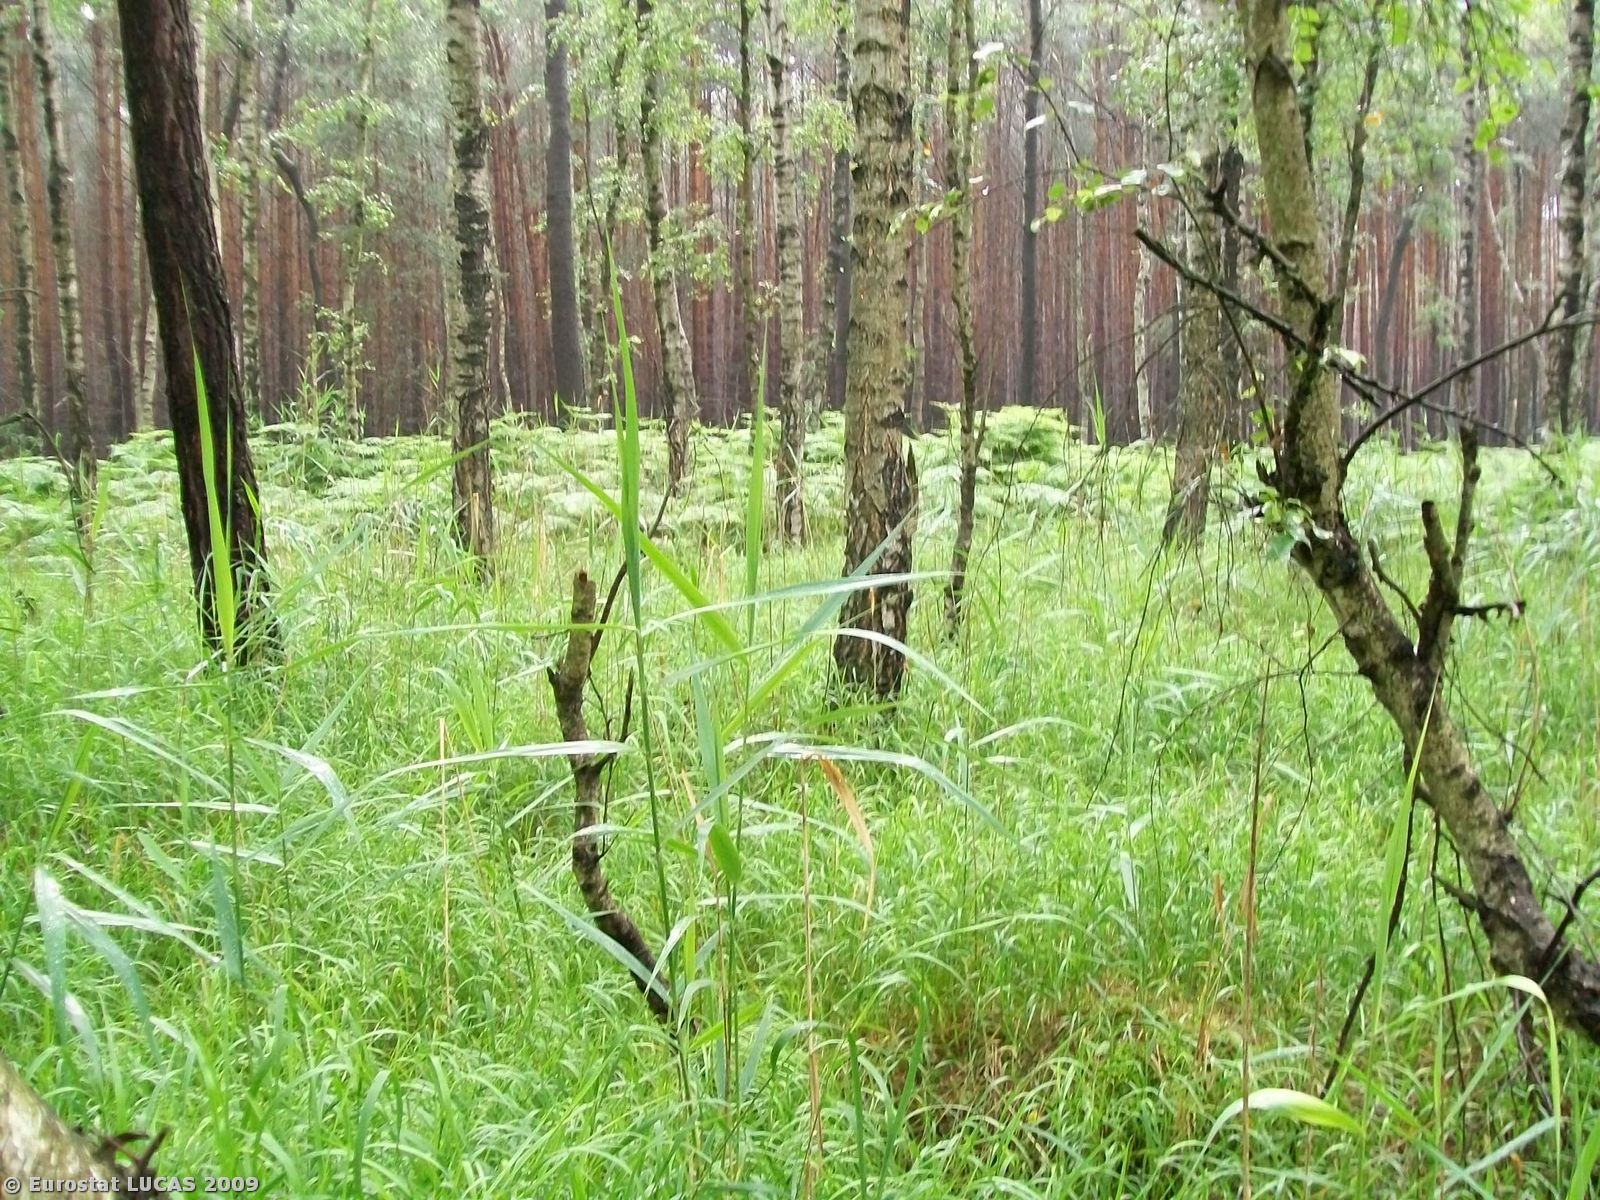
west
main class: Woodland
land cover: Mixed woodland
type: hemiboreal forest and nemoral coniferous forest and mixed broadleaved-coniferous forest
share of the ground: > 75 %
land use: Nature reserves
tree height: > 5 m
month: June
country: PL
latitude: 51.3455
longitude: 15.1862
